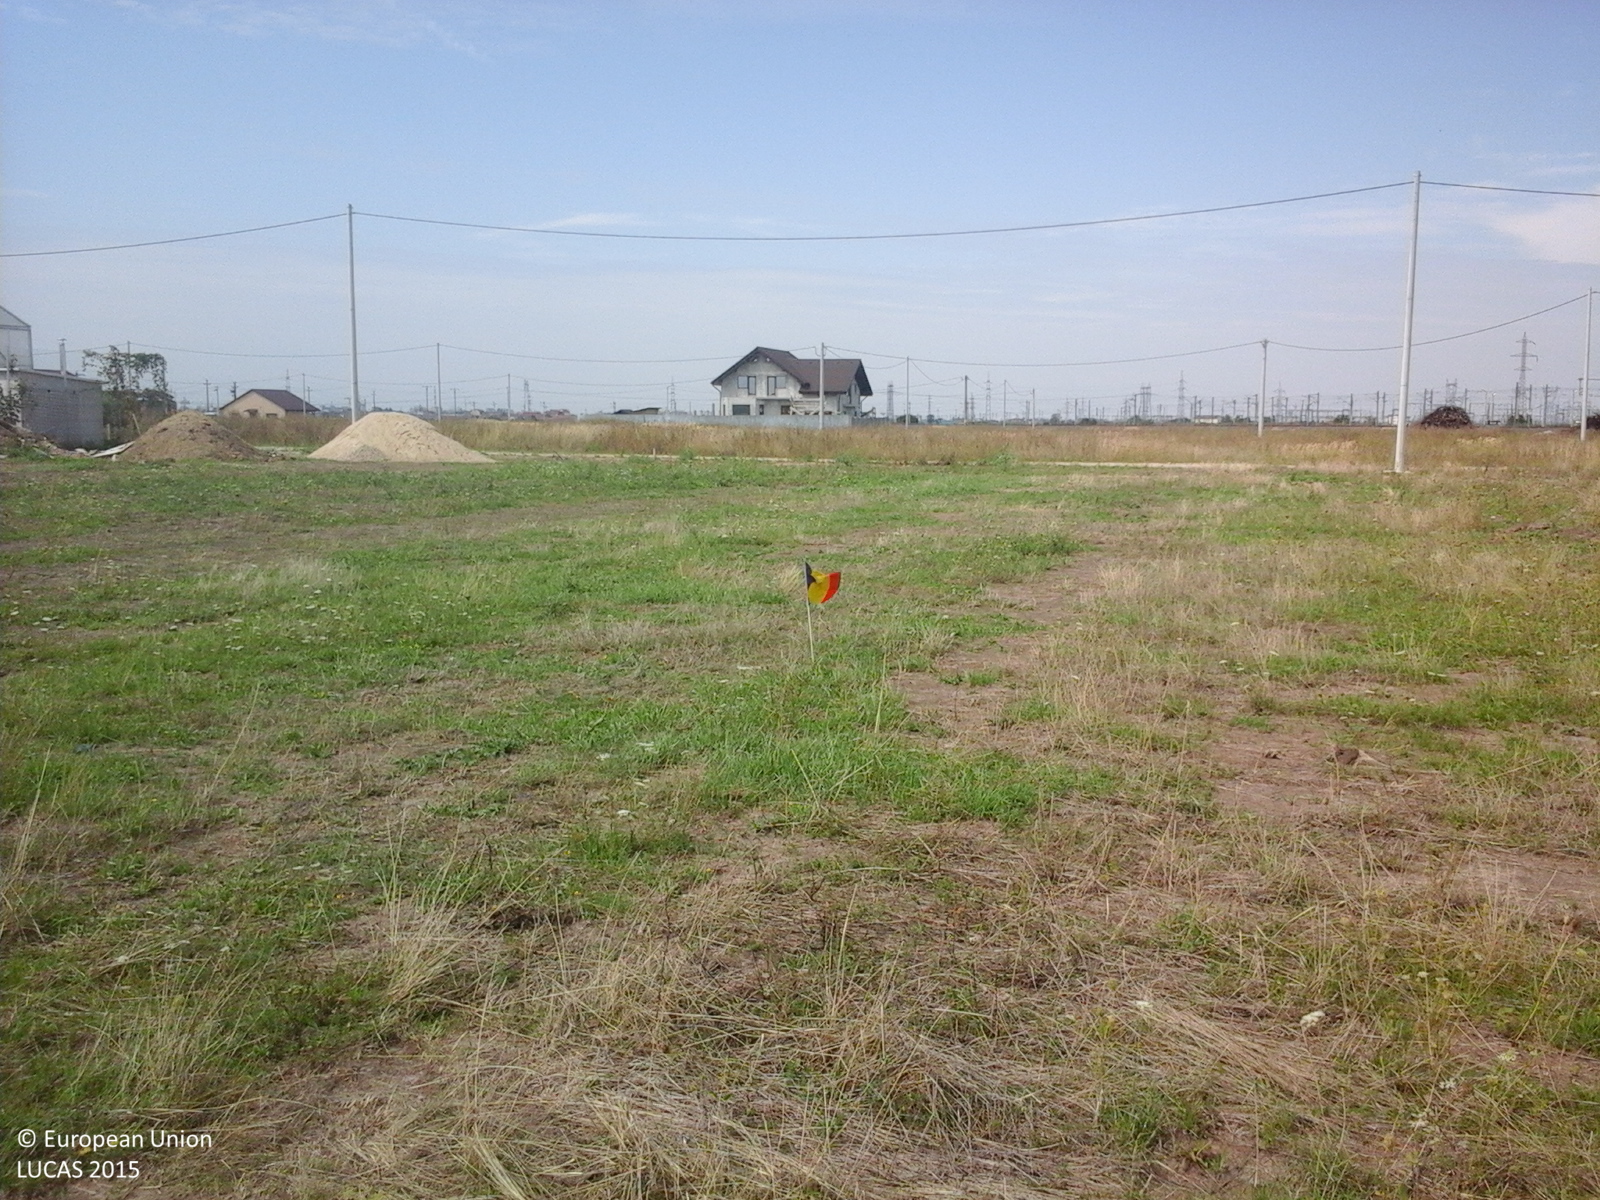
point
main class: Grassland
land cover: Grassland without tree/shrub cover
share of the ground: > 75 %
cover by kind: herbaceous plants 100 %
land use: Agriculture (excluding fallow land and kitchen gardens)
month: August
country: RO
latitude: 46.1765
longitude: 21.3952
